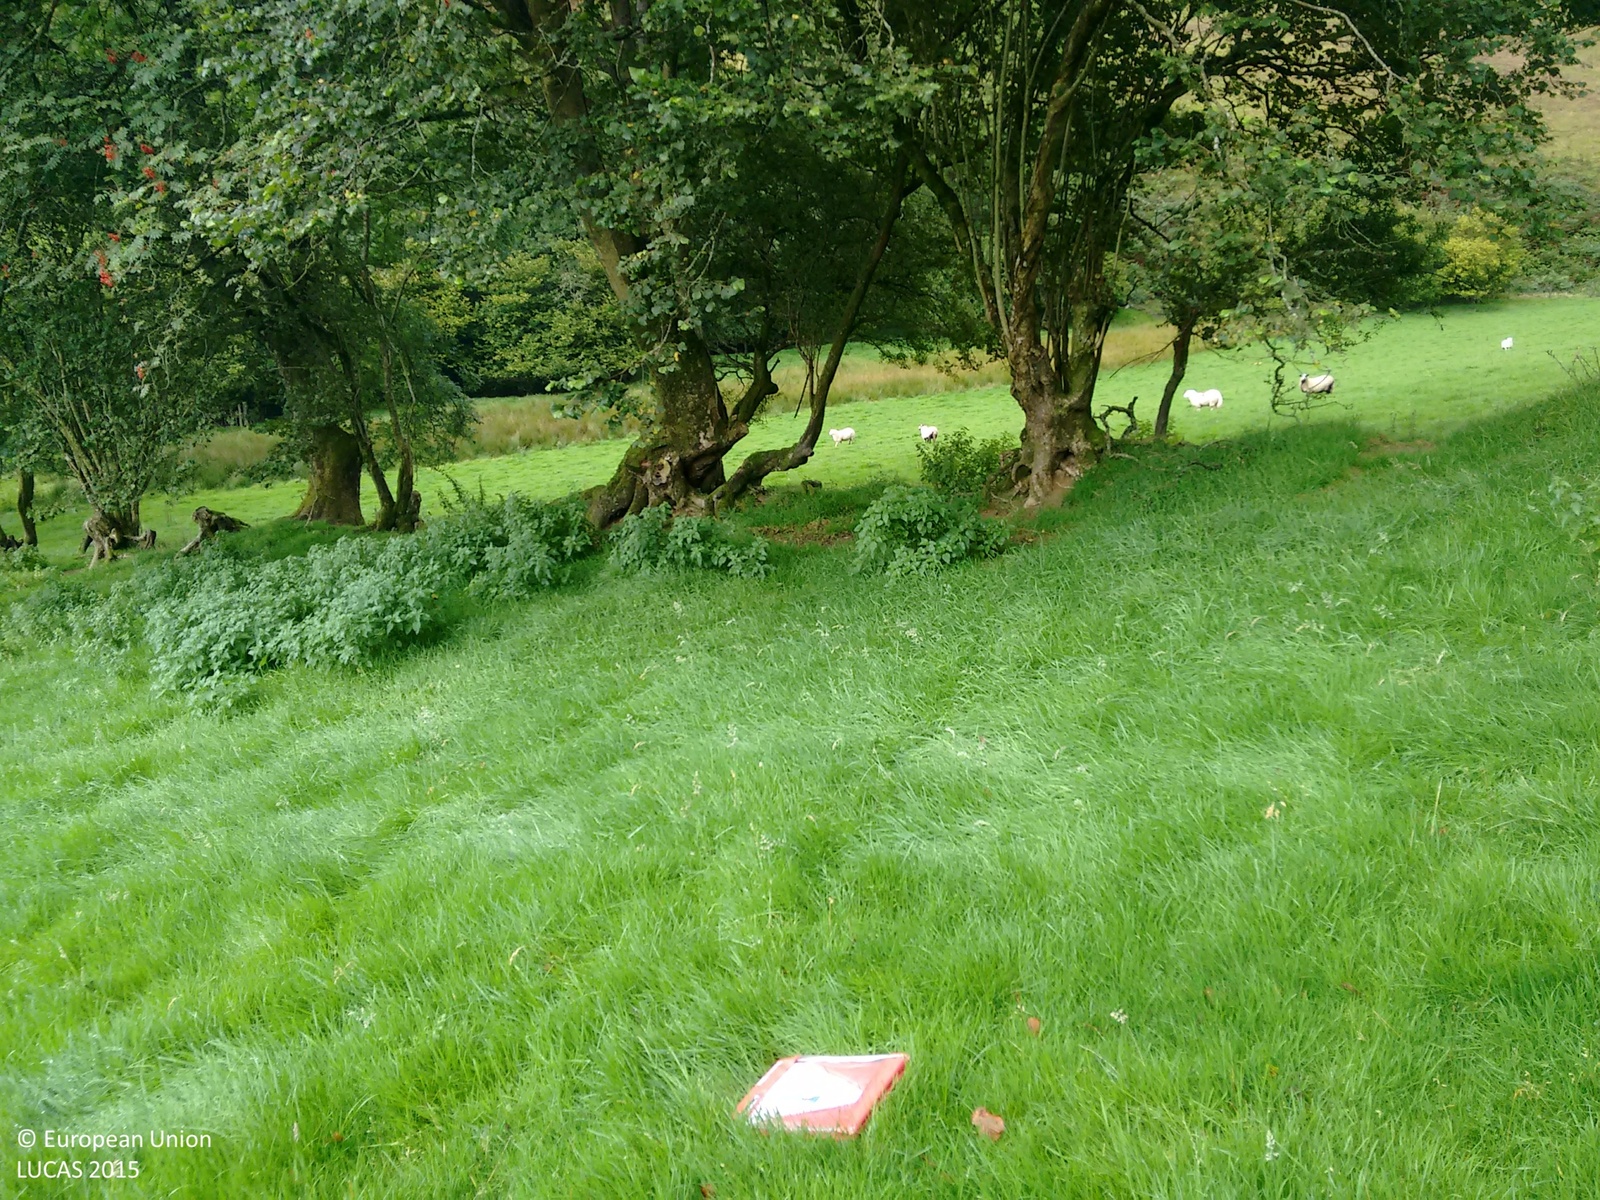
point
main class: Grassland
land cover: Grassland without tree/shrub cover
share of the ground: > 75 %
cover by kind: herbaceous plants 100 %
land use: Agriculture (excluding fallow land and kitchen gardens)
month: September
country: GB
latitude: 52.0926
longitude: -3.8258
